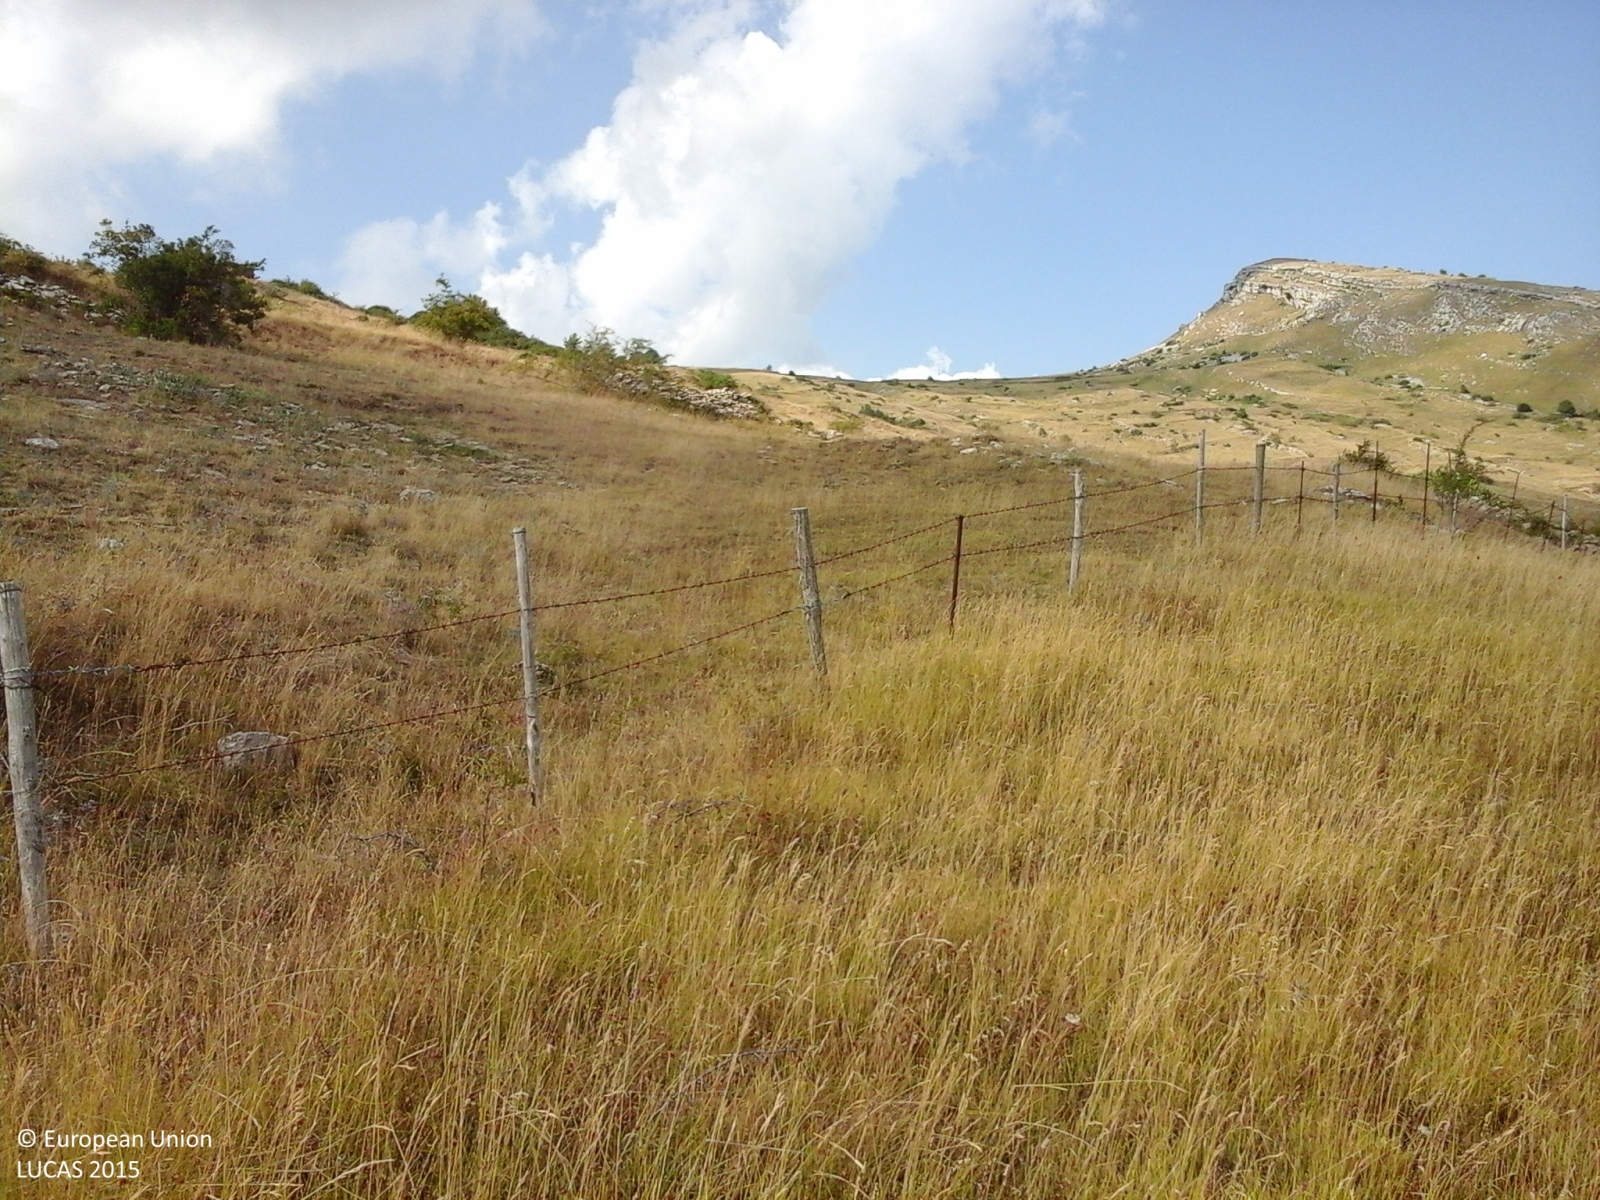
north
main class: Grassland
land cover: Grassland without tree/shrub cover
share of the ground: > 75 %
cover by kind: herbaceous plants 100 %
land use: Agriculture (excluding fallow land and kitchen gardens)
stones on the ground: 25 - 50 %
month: August
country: IT
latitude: 41.8388
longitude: 14.3087
